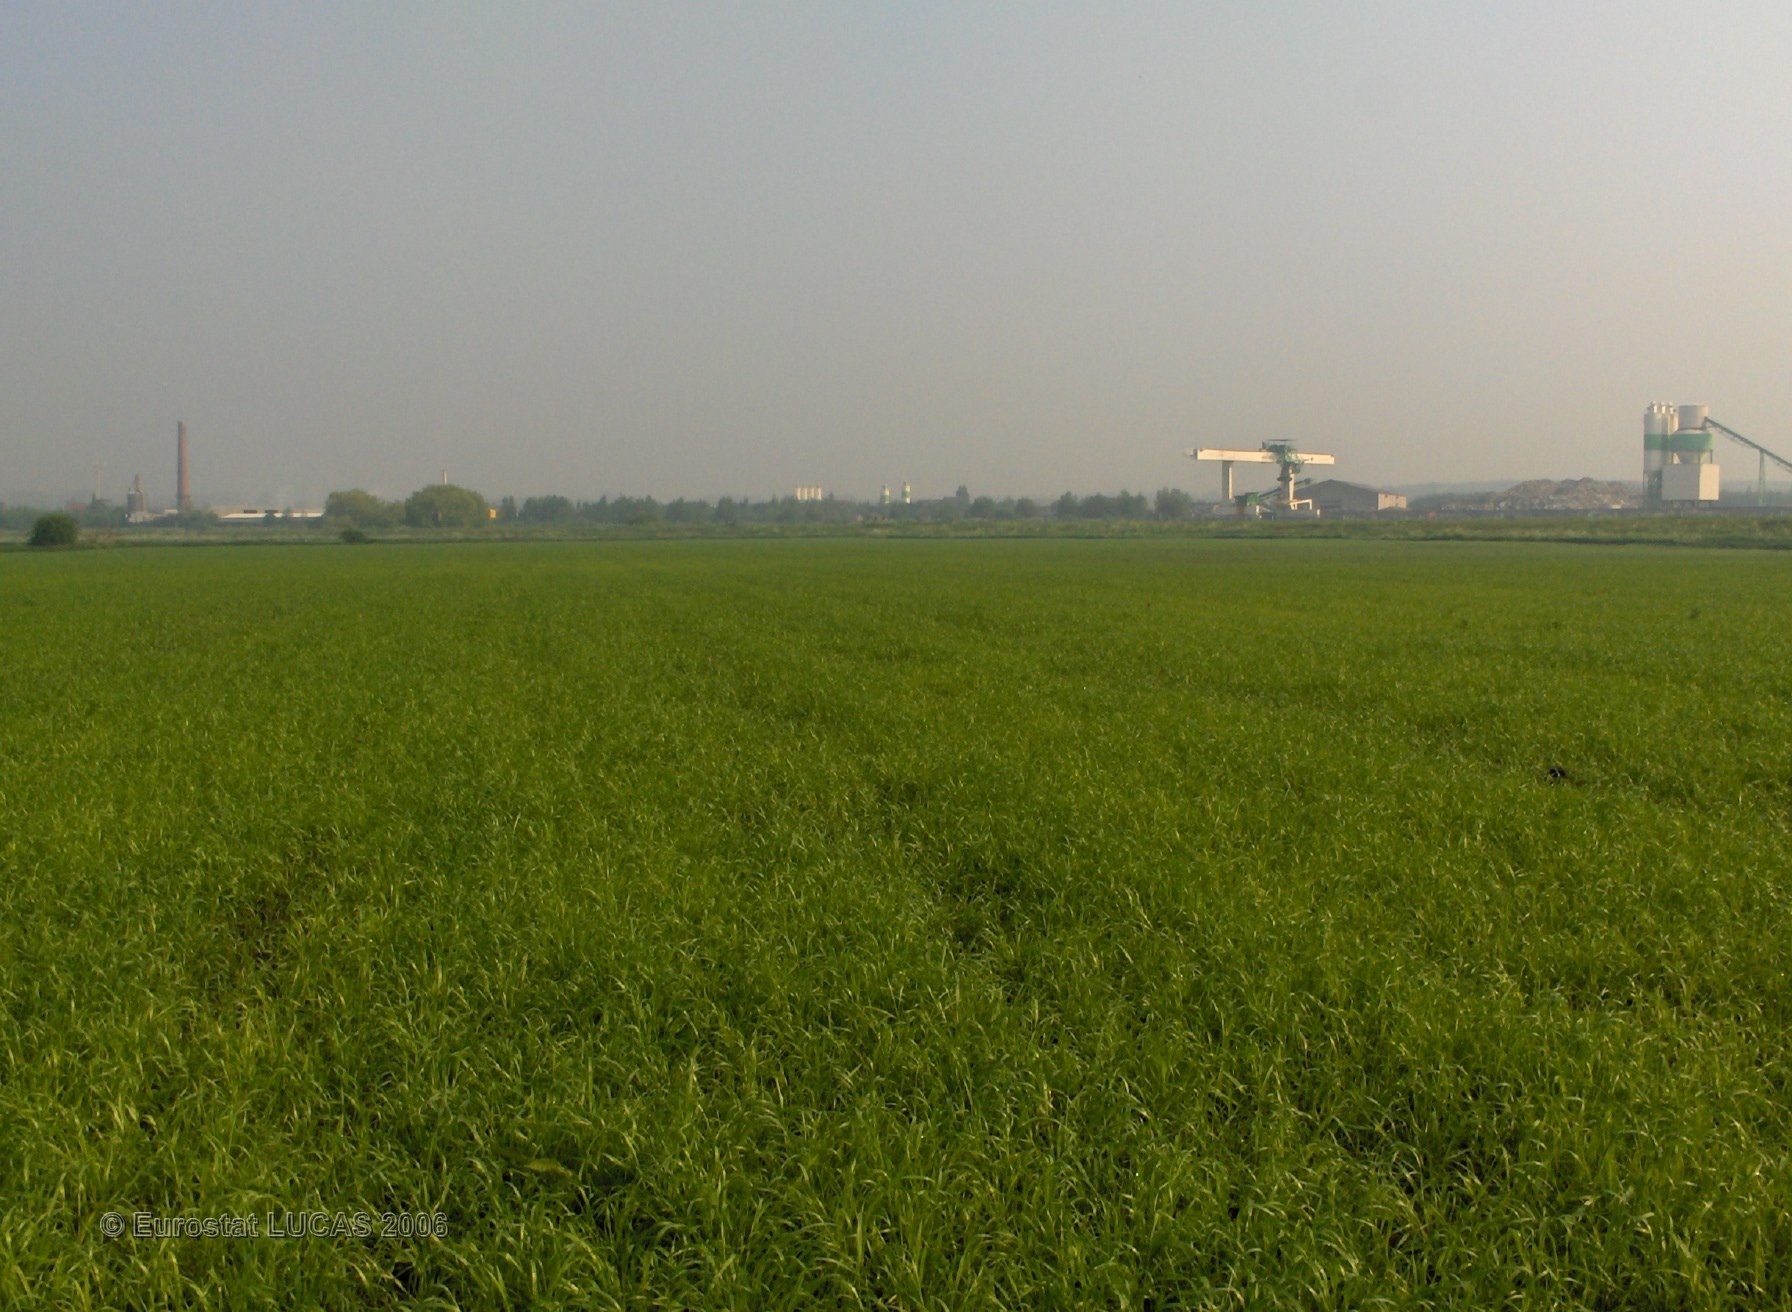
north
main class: Cropland
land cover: Triticale
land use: Agriculture (excluding fallow land and kitchen gardens)
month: May
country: BE
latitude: 51.0747
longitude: 4.4149
